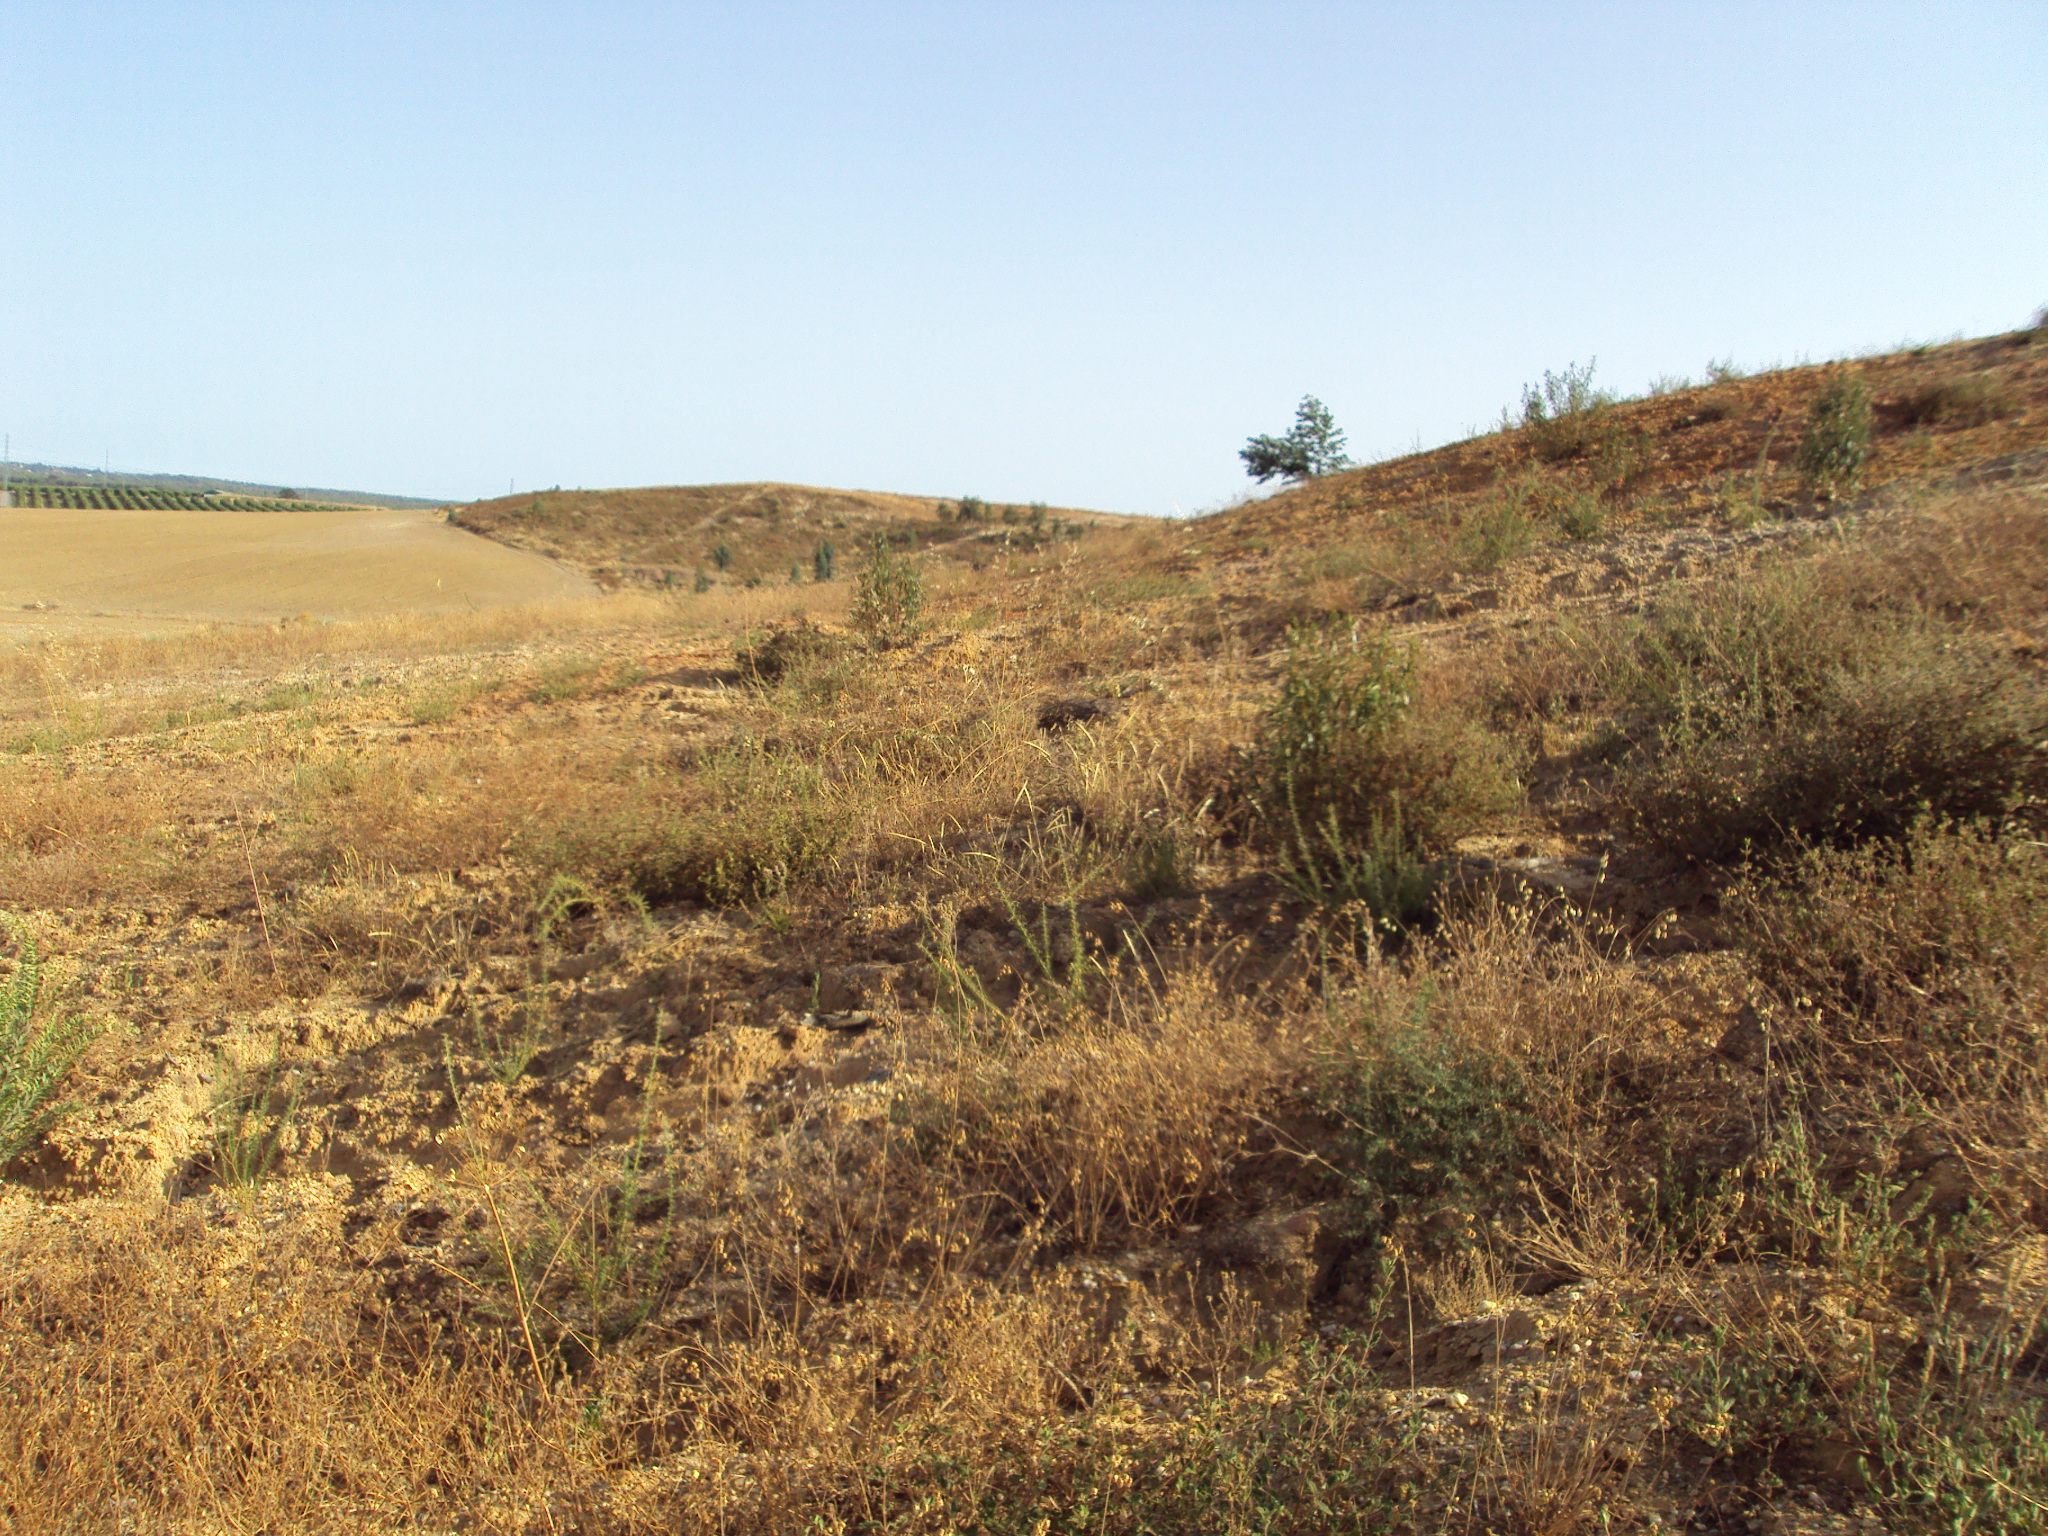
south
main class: Grassland
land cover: Spontaneously vegetated surfaces
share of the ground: > 75 %
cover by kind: herbaceous plants 65 %, unconsolidated bare surface 30 %, shrubs 5 %
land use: Agriculture (excluding fallow land and kitchen gardens)
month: July
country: ES
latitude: 37.3367
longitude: -7.0743
